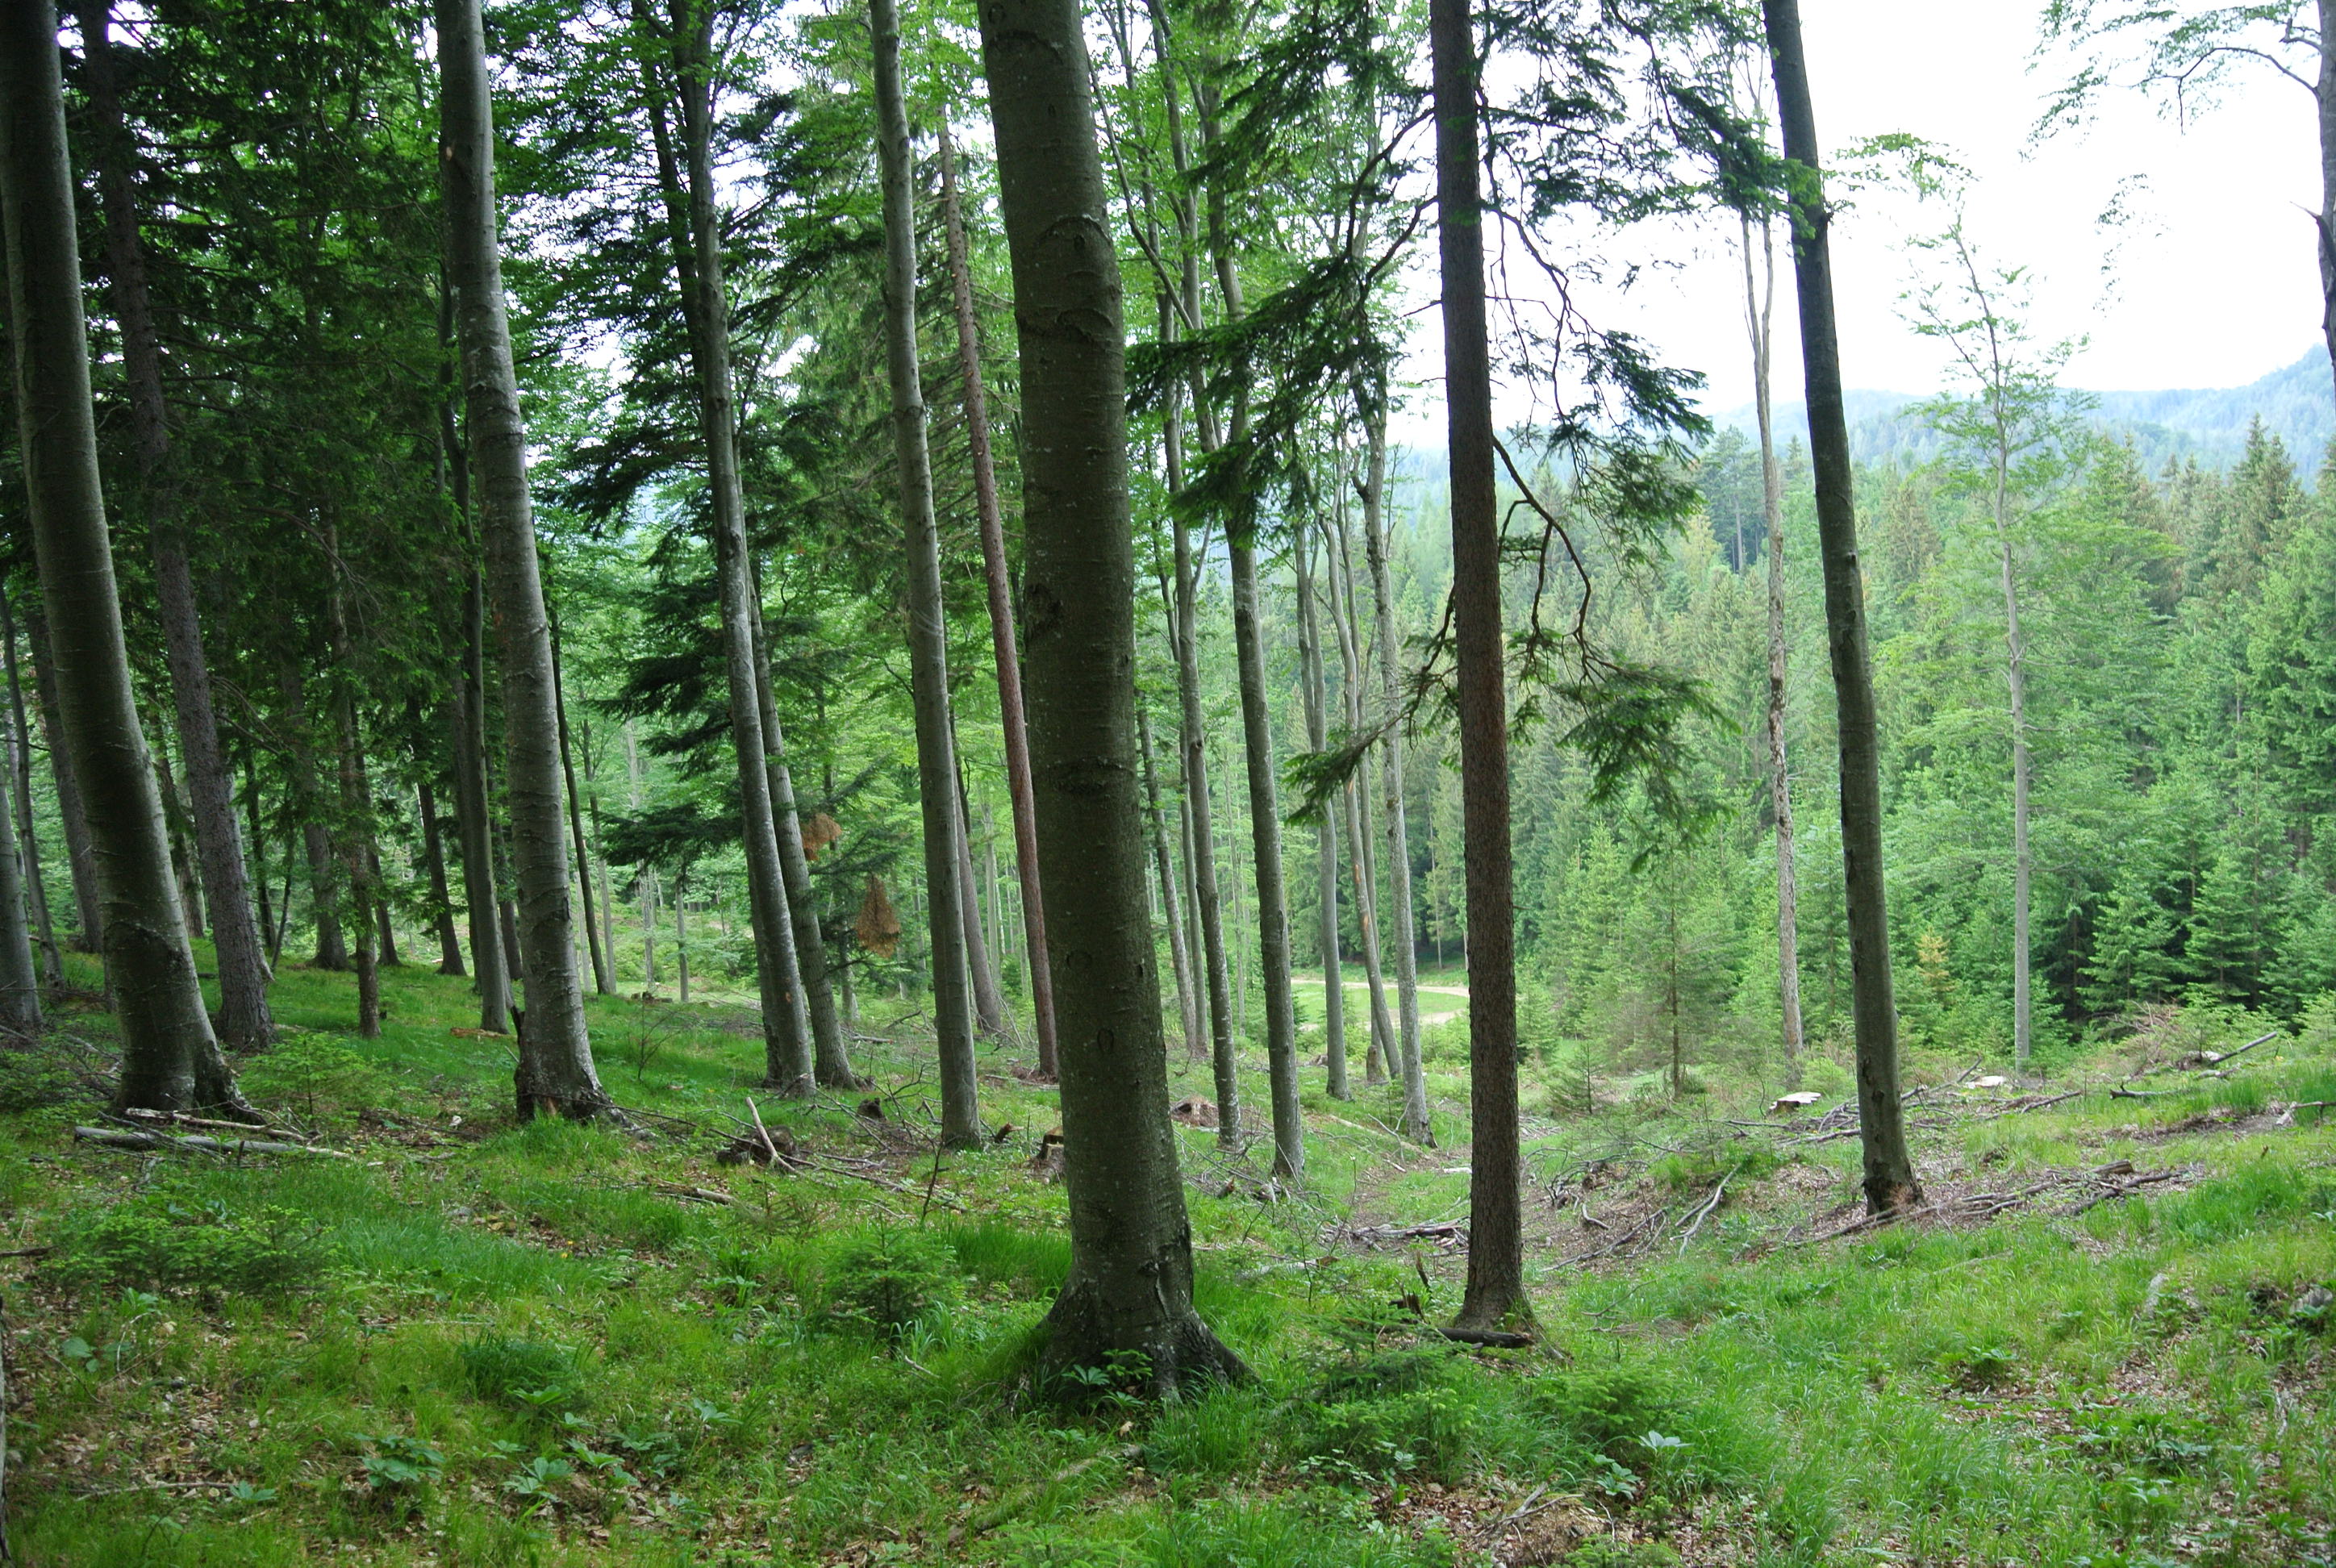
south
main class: Woodland
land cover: Other mixed woodland
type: hemiboreal forest and nemoral coniferous forest and mixed broadleaved-coniferous forest
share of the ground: > 75 %
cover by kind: broadleaved forest trees 50 %, coniferous forest trees 45 %, herbaceous plants 5 %
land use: Forestry
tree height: > 5 m
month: June
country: AT
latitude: 47.9087
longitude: 15.7957
